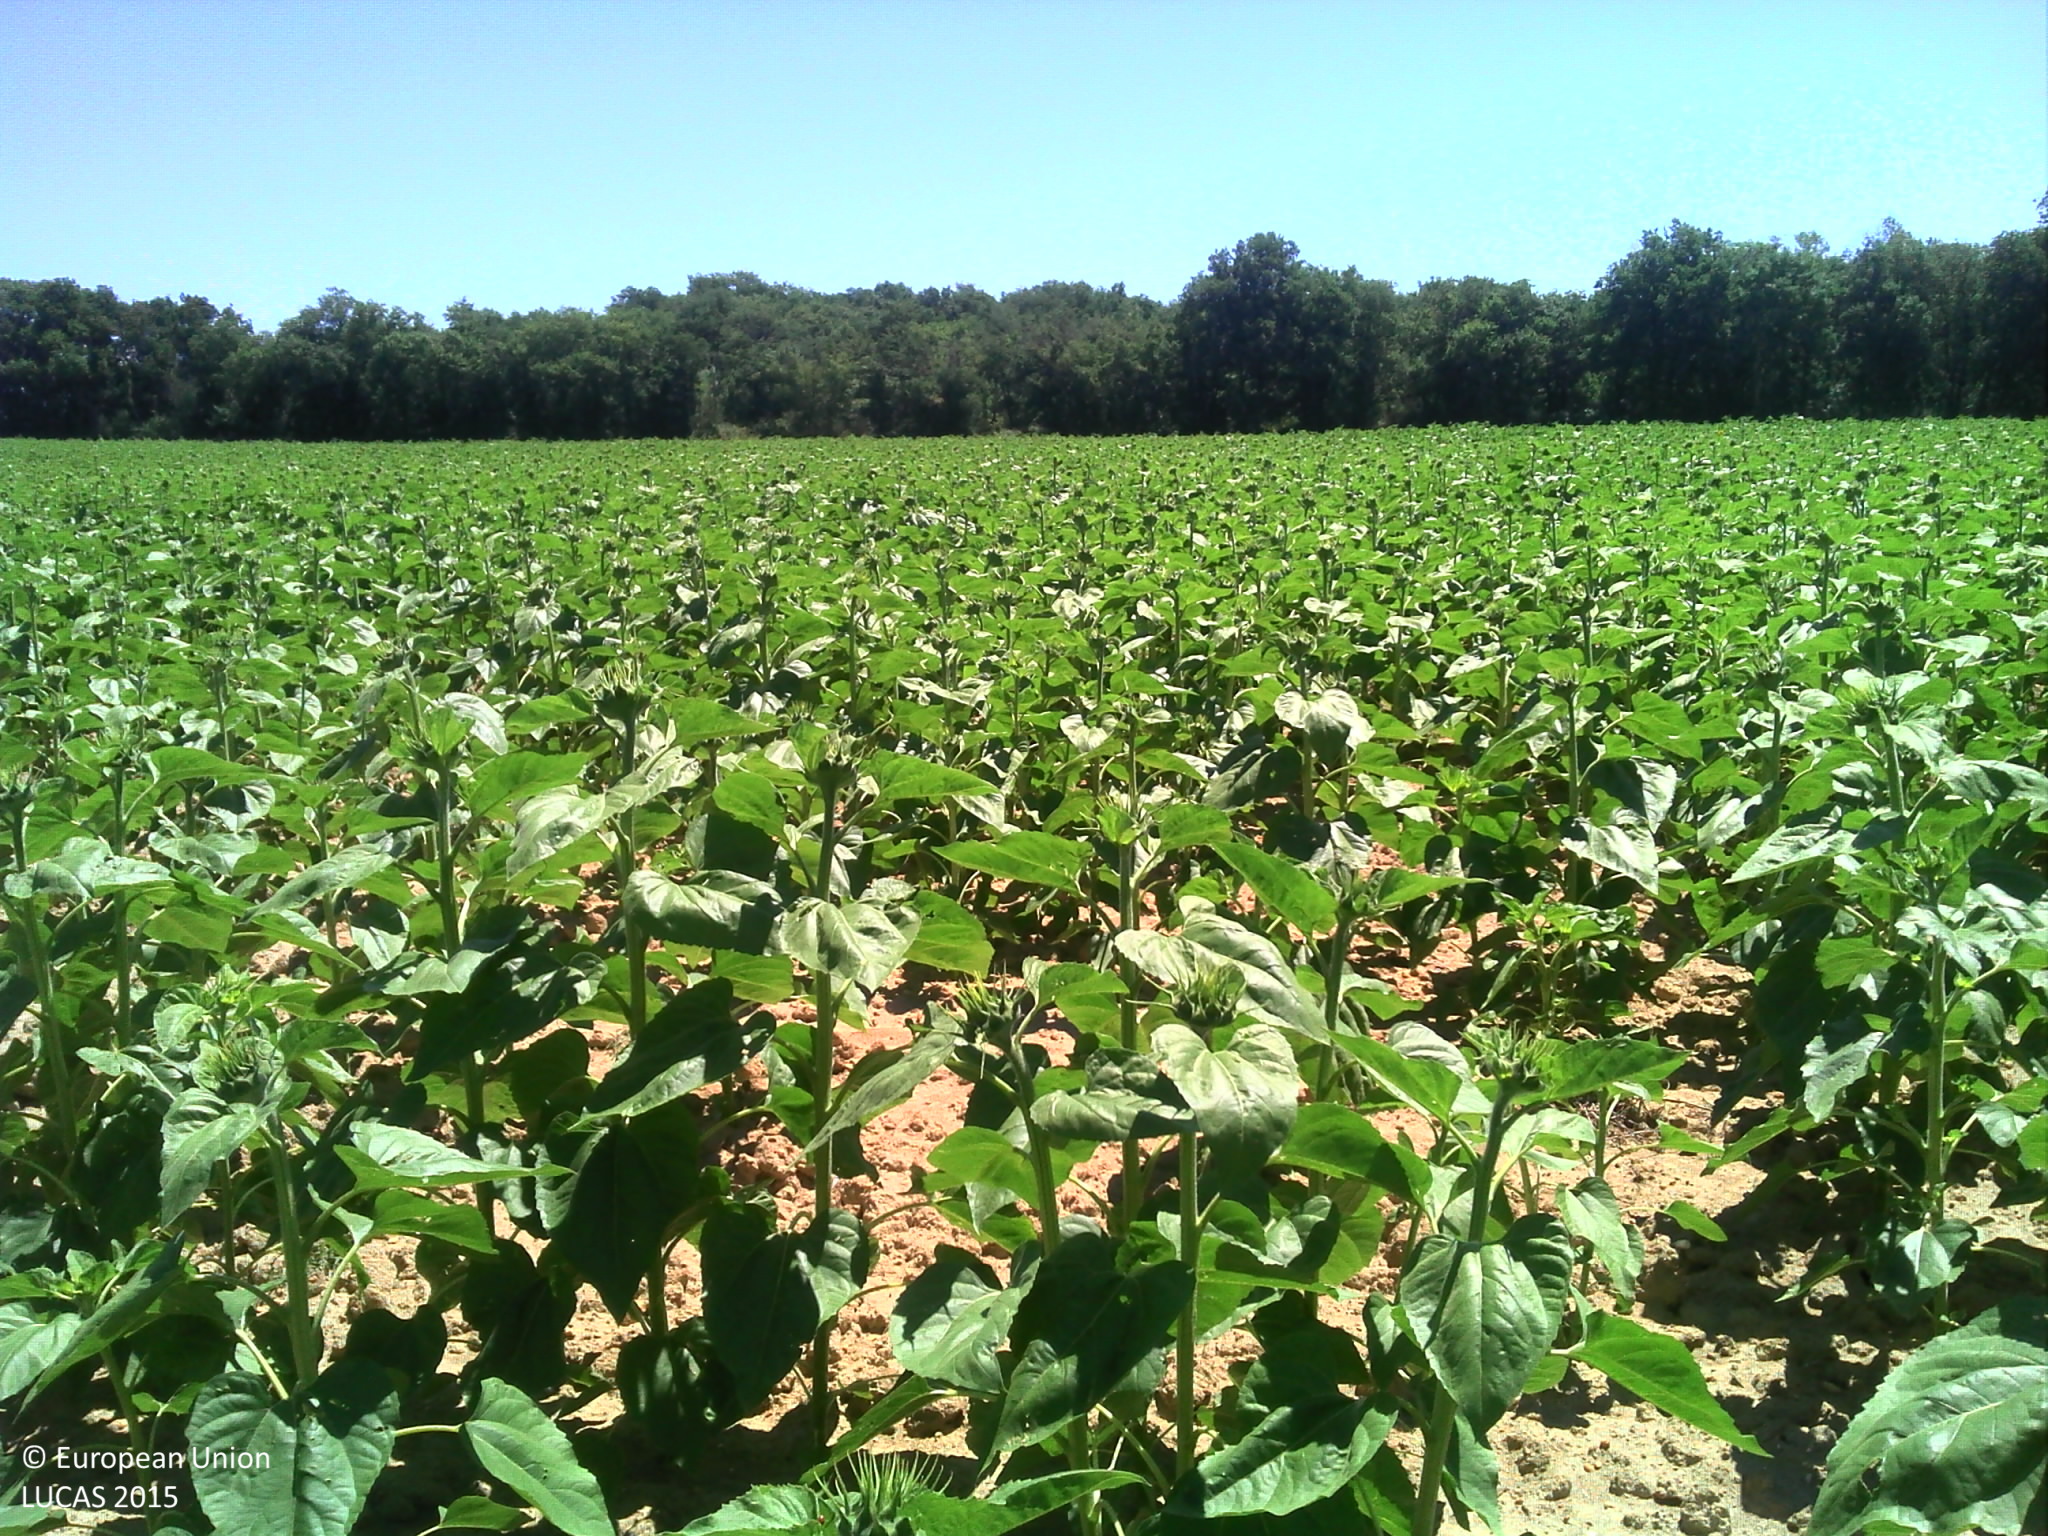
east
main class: Cropland
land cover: Sunflower
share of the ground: 50 - 75 %
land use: Agriculture (excluding fallow land and kitchen gardens)
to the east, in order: Sunflower; Grass margins; Sunflower; Broadleaved woodland; Temporary grasslands
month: June
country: FR
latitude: 43.3187
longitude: 2.0286
